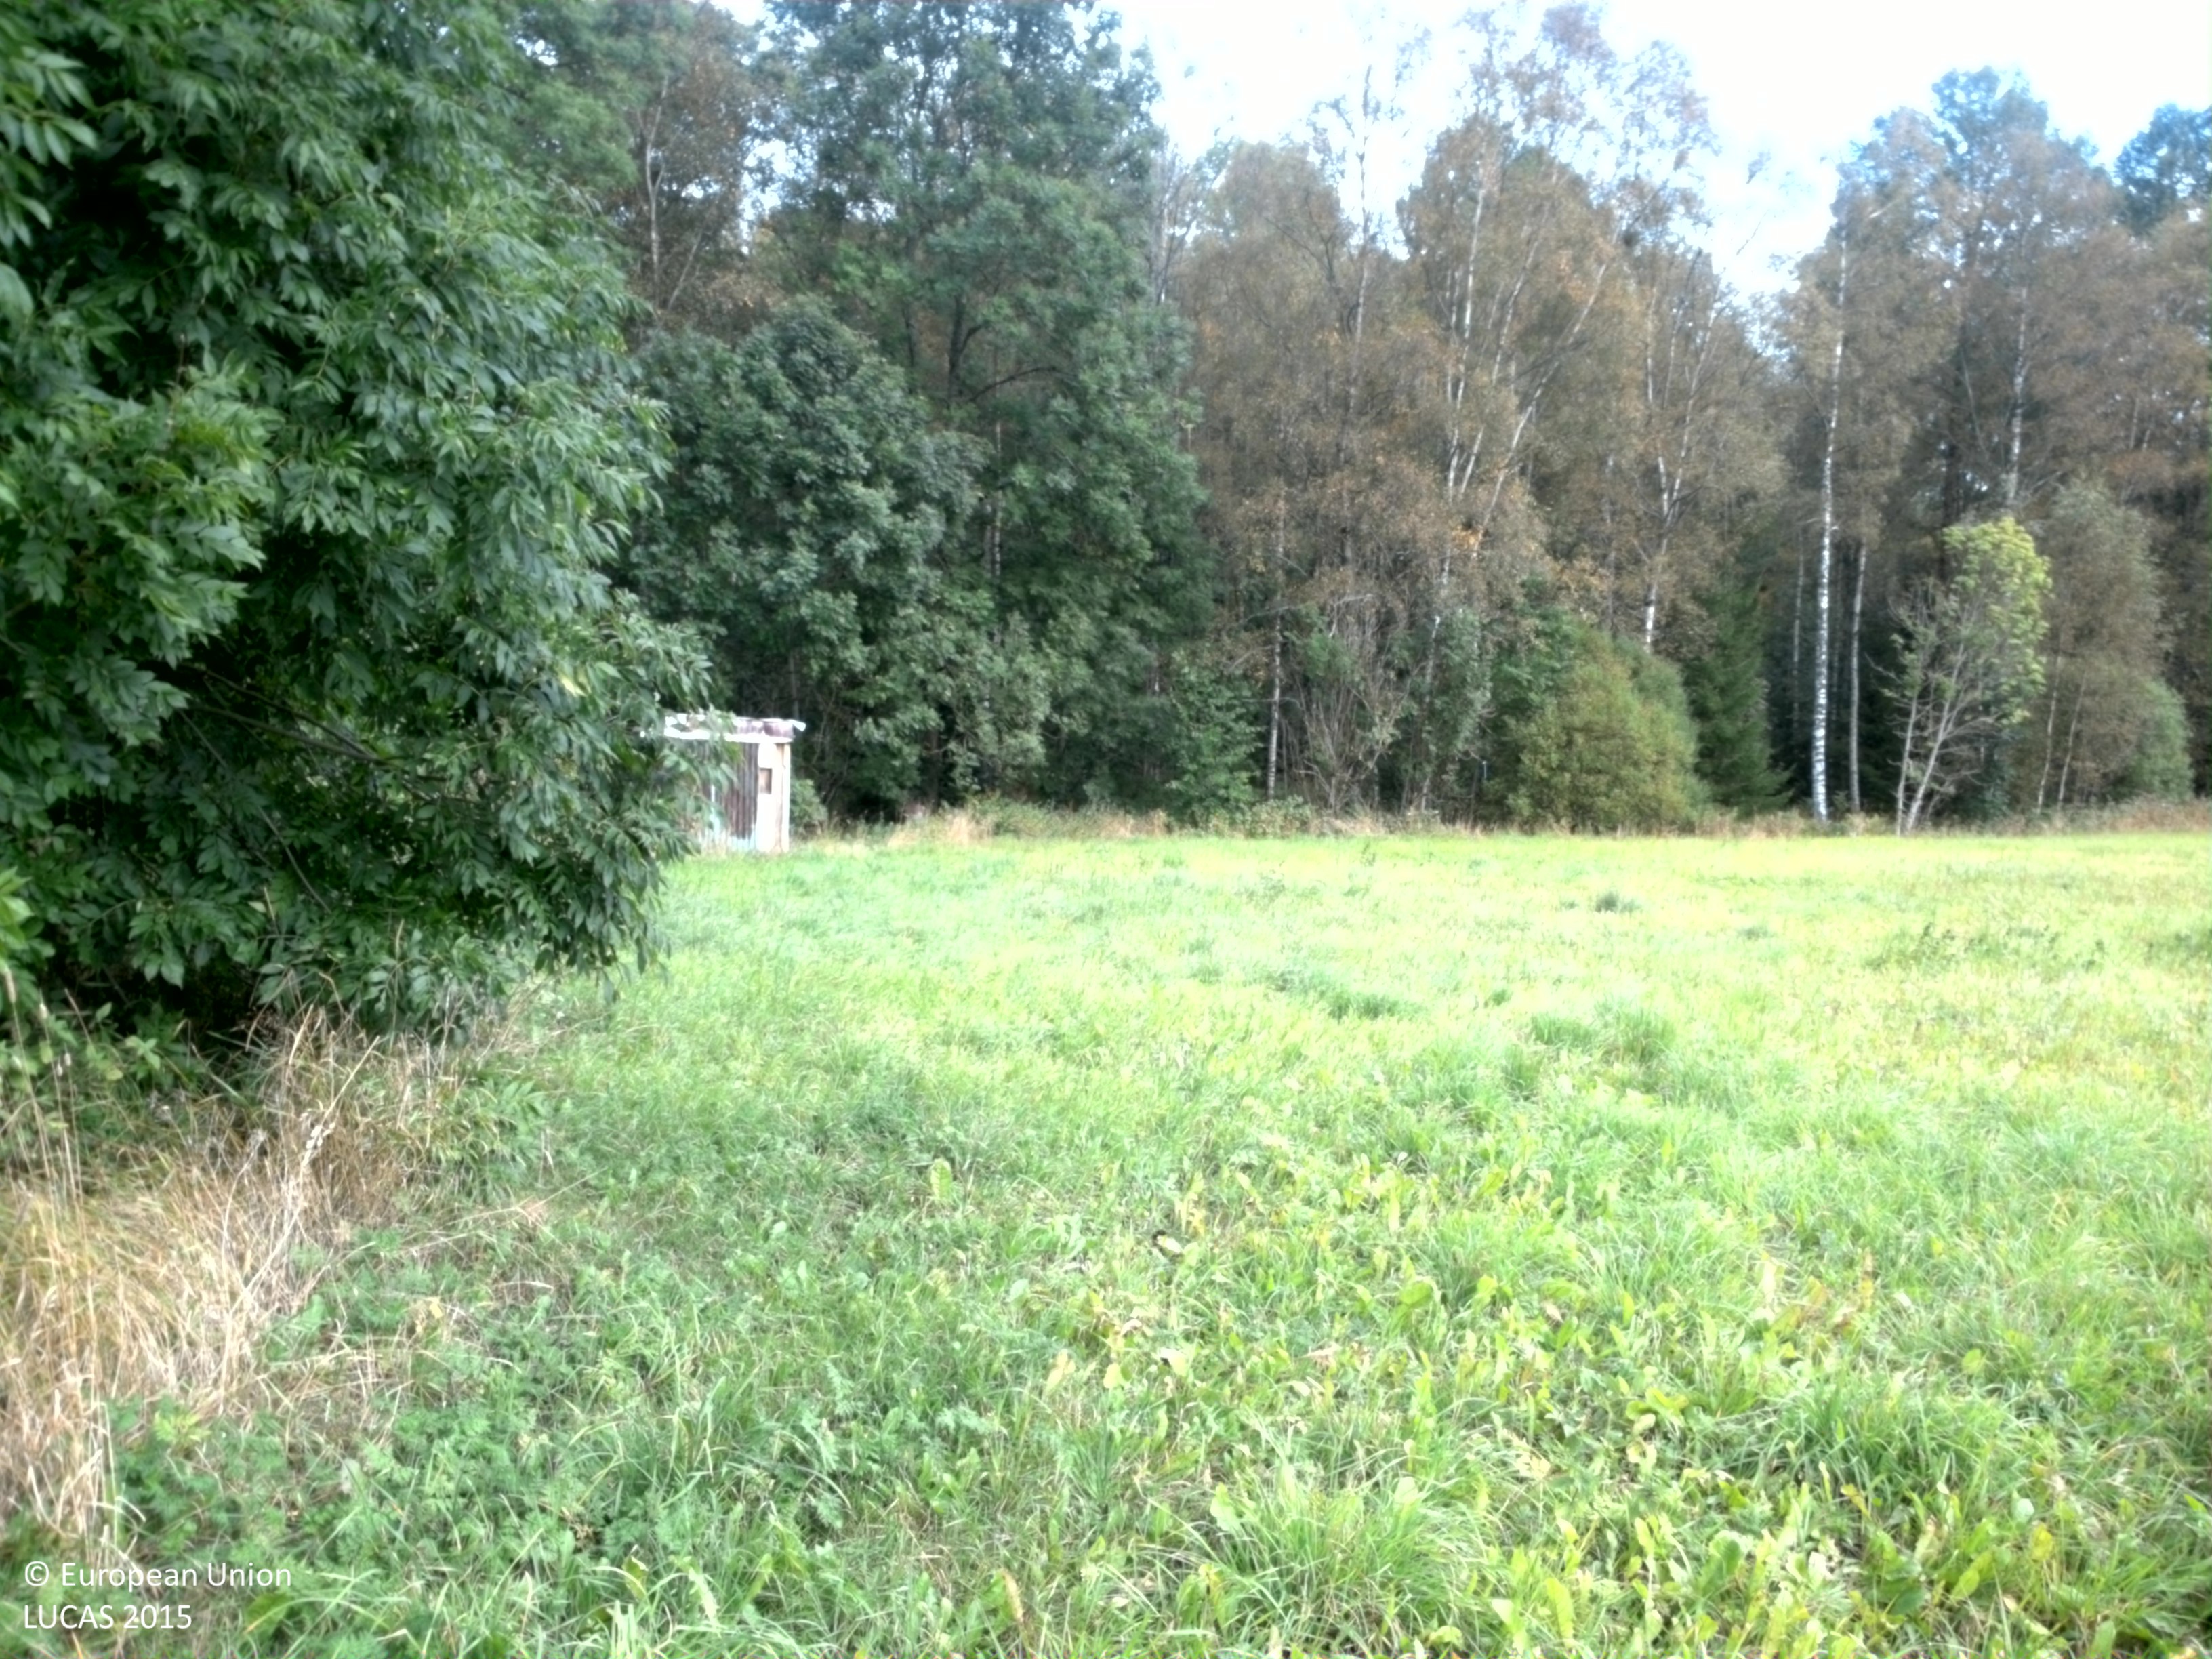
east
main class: Grassland
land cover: Grassland without tree/shrub cover
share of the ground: > 75 %
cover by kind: herbaceous plants 100 %
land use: Agriculture (excluding fallow land and kitchen gardens)
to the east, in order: Grassland without tree/shrub cover; Broadleaved woodland; Fences; Broadleaved woodland; Rivers and streams; Broadleaved woodland; Rivers and streams; Broadleaved woodland; Tracks; Broadleaved woodland; Spruce dominated mixed woodland; Fences; Spruce dominated mixed woodland; Tracks; Spruce dominated mixed woodland
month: September
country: SE
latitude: 58.8700
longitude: 14.3455
